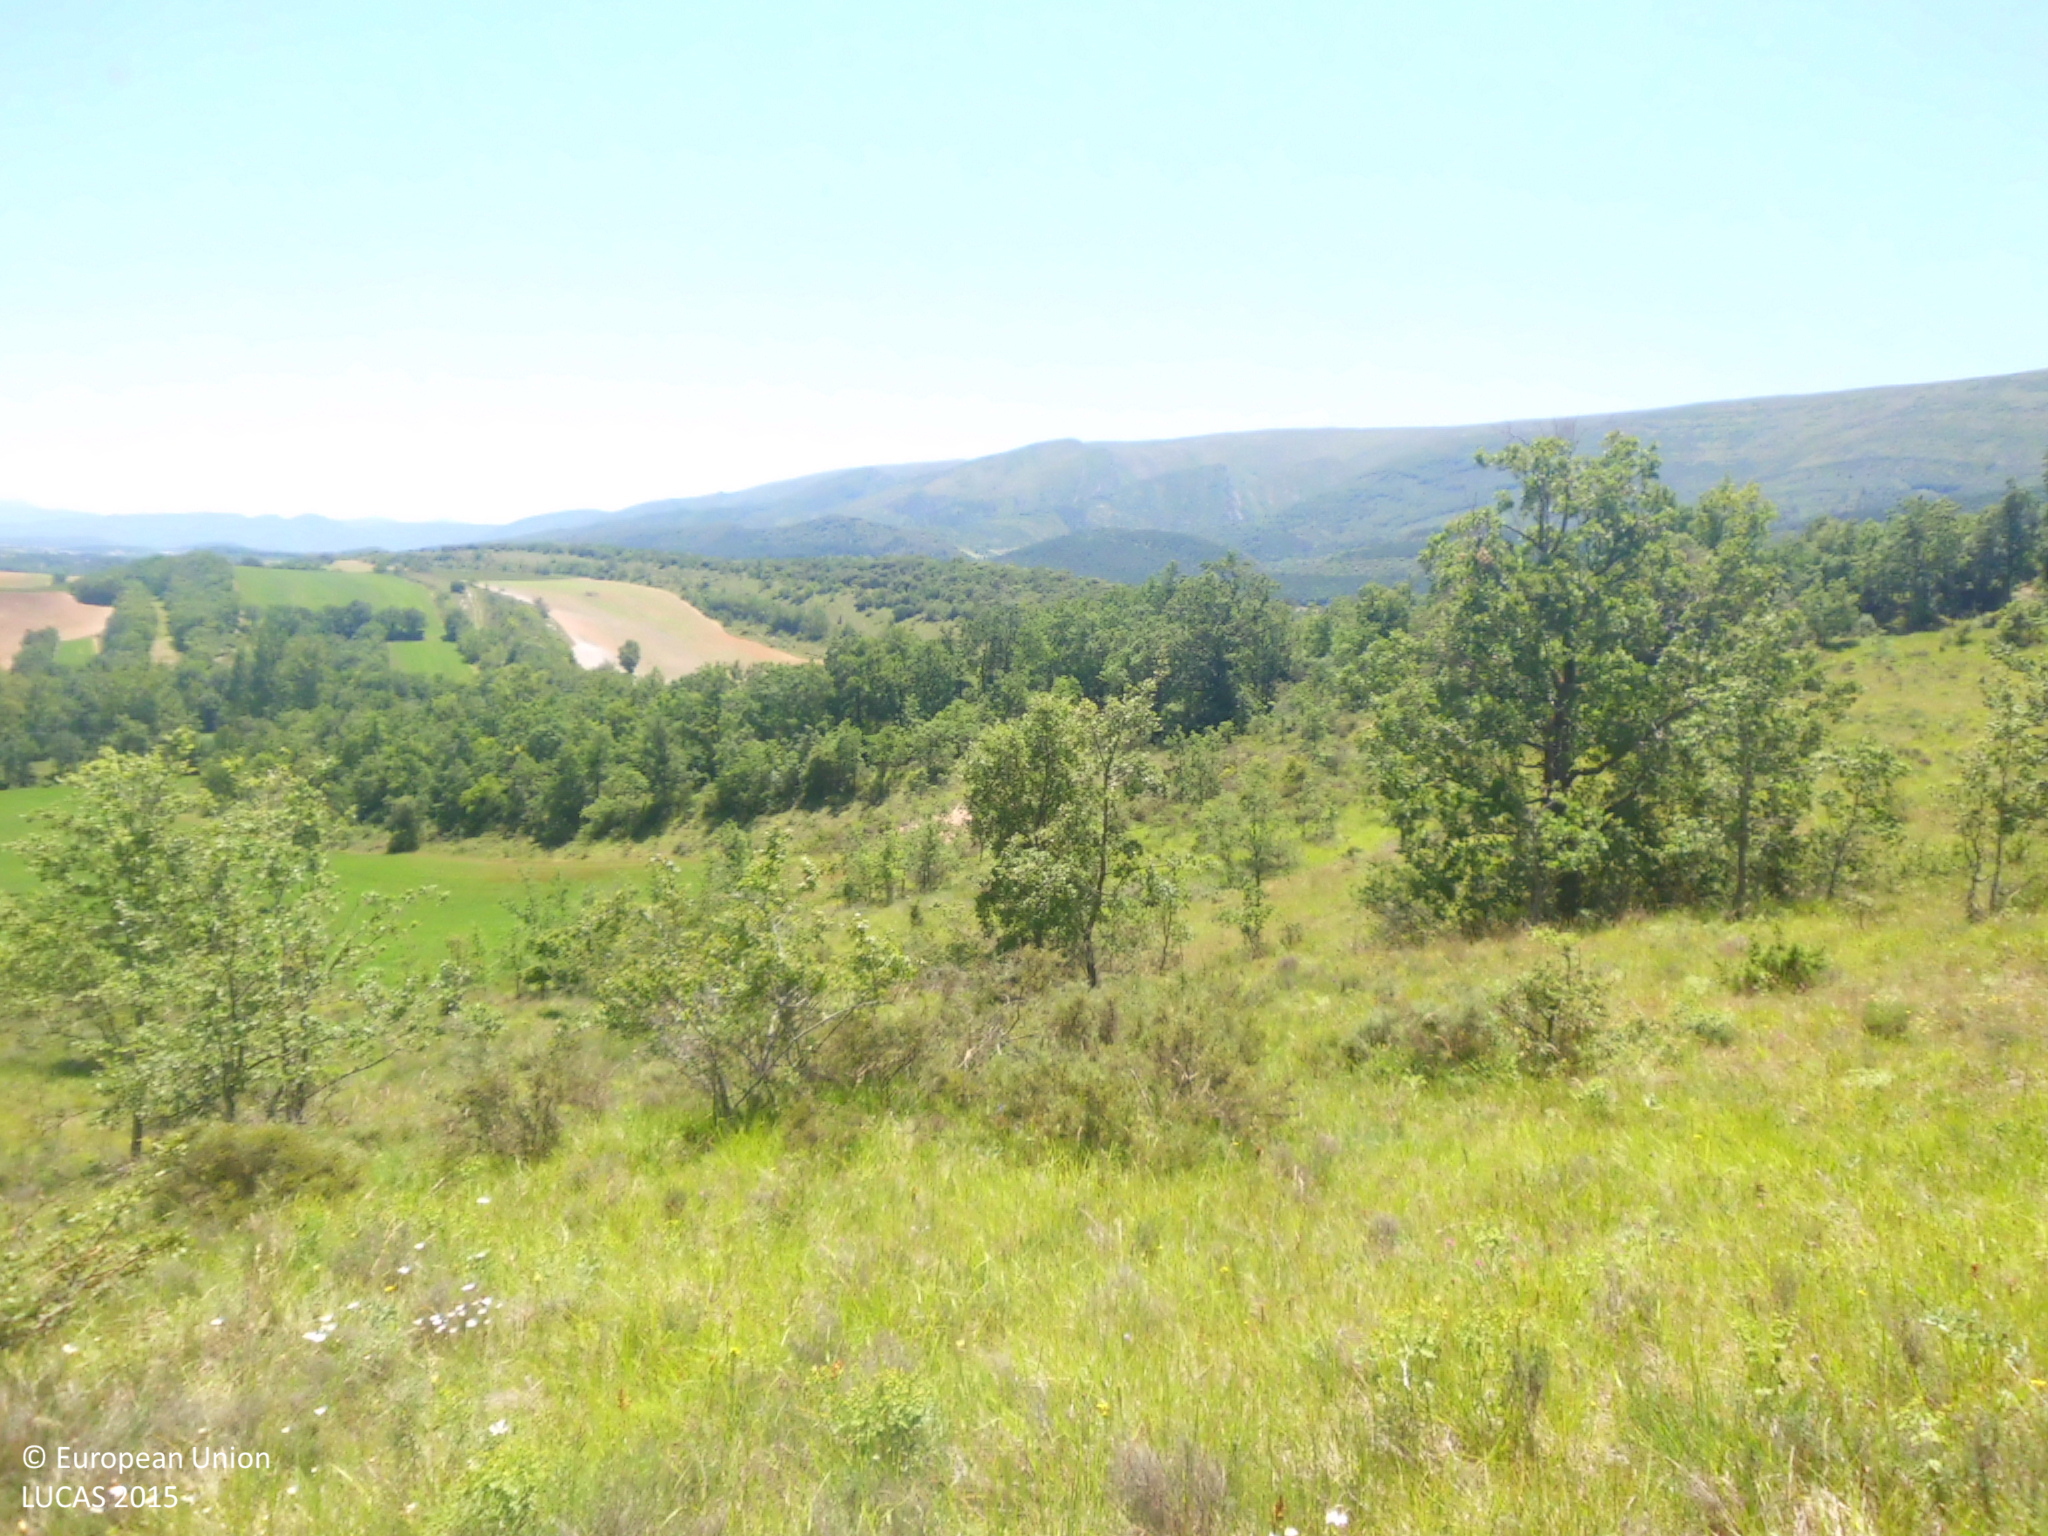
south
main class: Grassland
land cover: Grassland with sparse tree/shrub cover
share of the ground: > 75 %
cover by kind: herbaceous plants 90 %, broadleaved forest trees 5 %, shrubs 5 %
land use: Abandoned areas
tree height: < 5 m
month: June
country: ES
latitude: 42.8654
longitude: -3.4654
